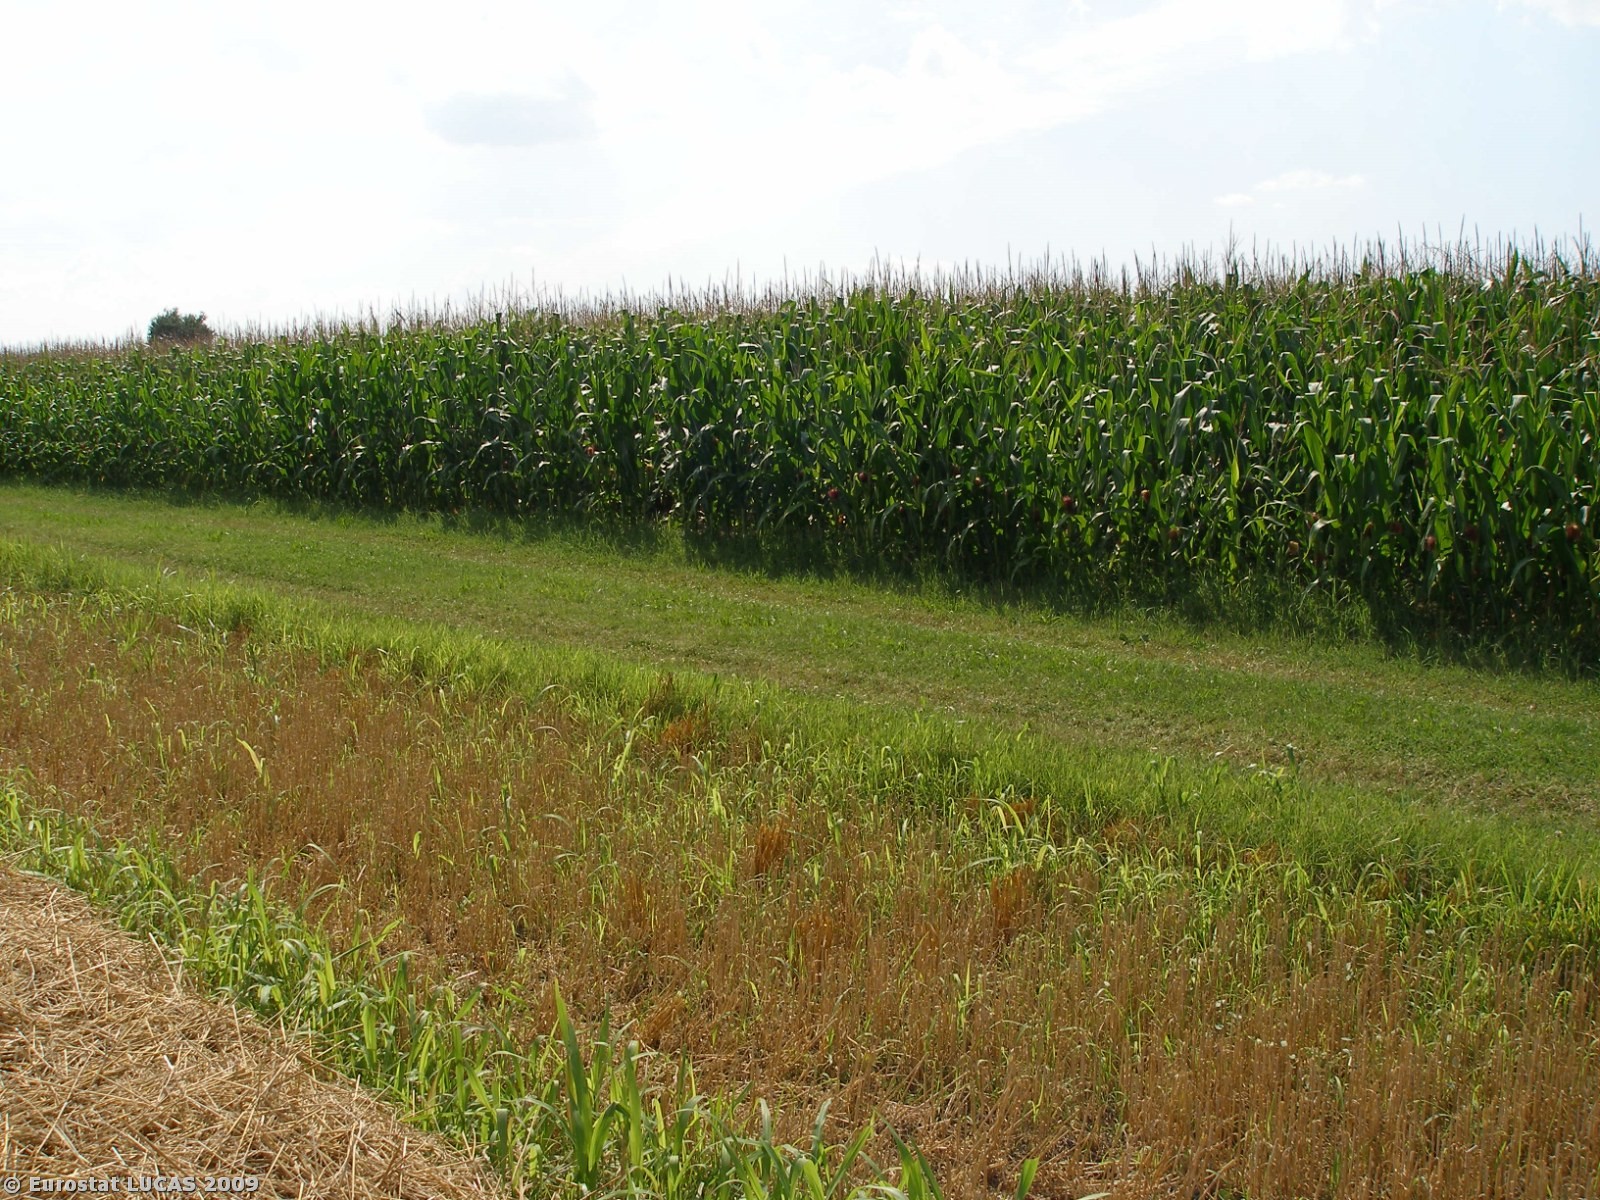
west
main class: Cropland
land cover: Maize
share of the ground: > 75 %
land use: Agriculture (excluding fallow land and kitchen gardens)
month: July
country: IT
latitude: 45.0880
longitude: 12.0419
